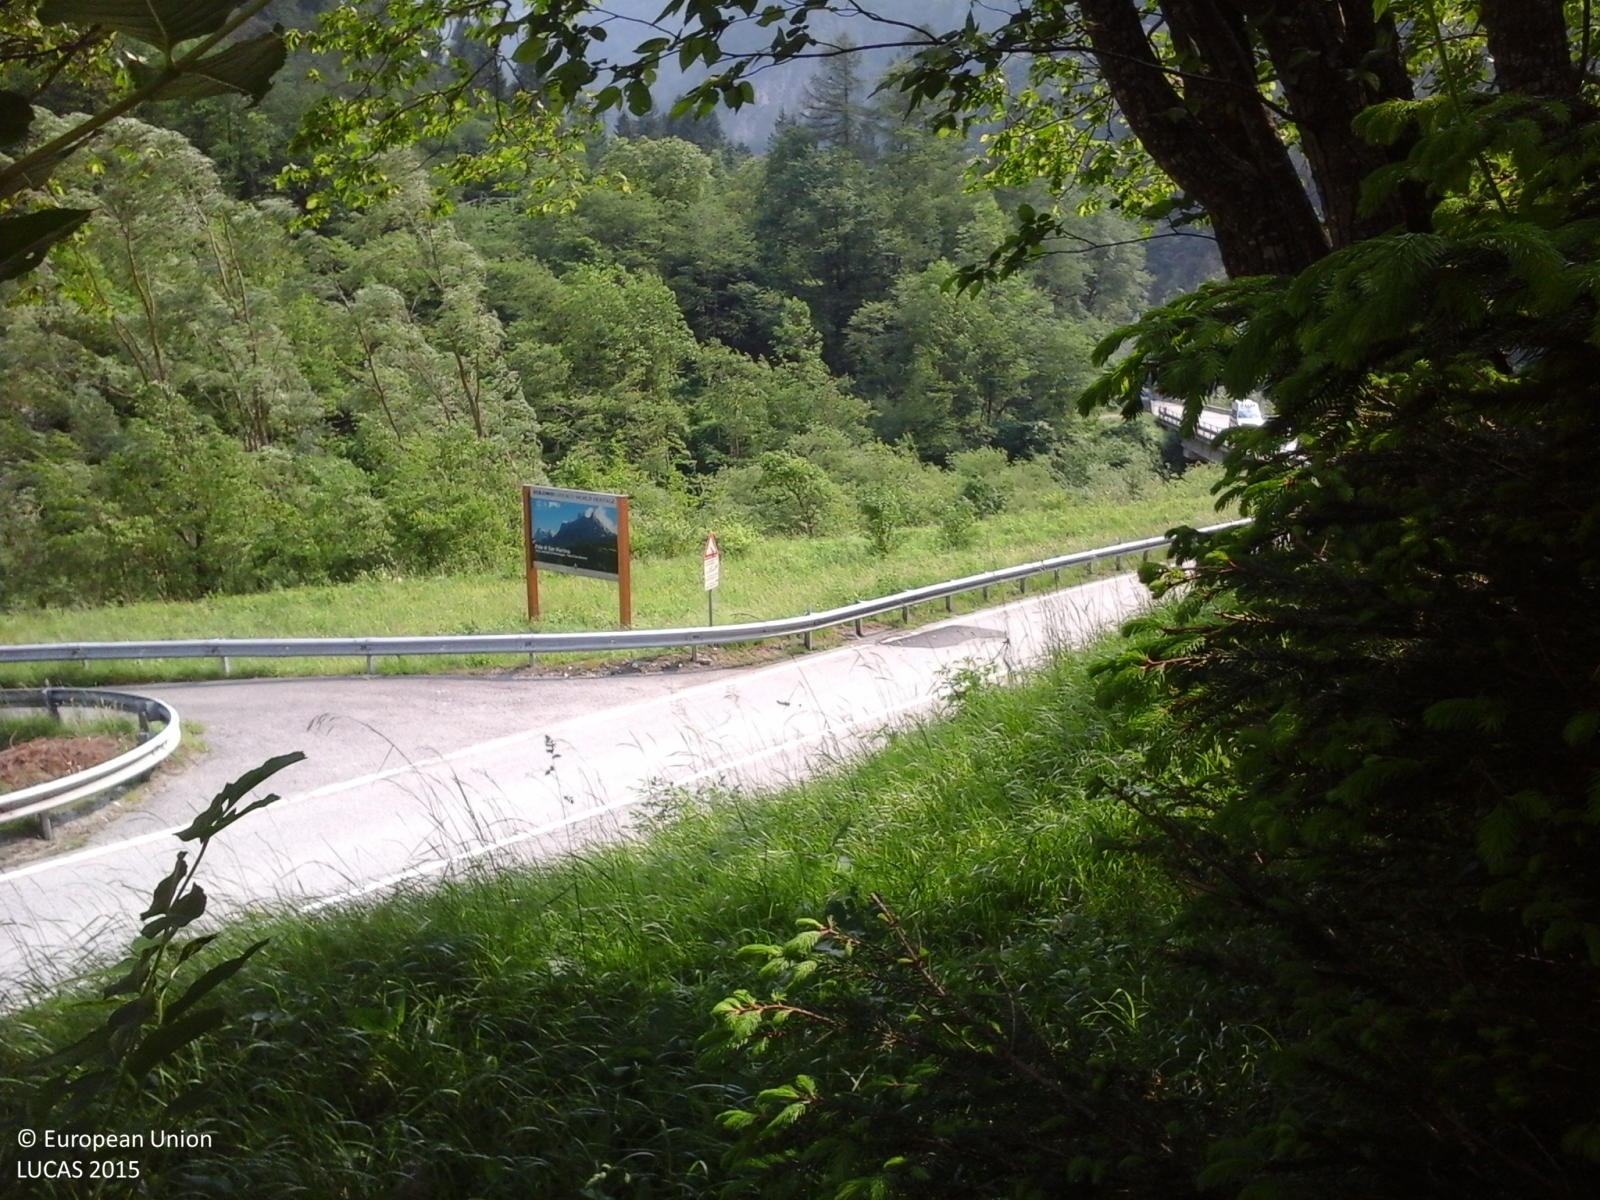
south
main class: Woodland
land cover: Other mixed woodland
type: alpine coniferous forest
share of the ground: > 75 %
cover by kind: coniferous forest trees 60 %, broadleaved forest trees 40 %
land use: Forestry
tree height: > 5 m
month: May
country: IT
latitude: 46.1384
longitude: 11.7711
